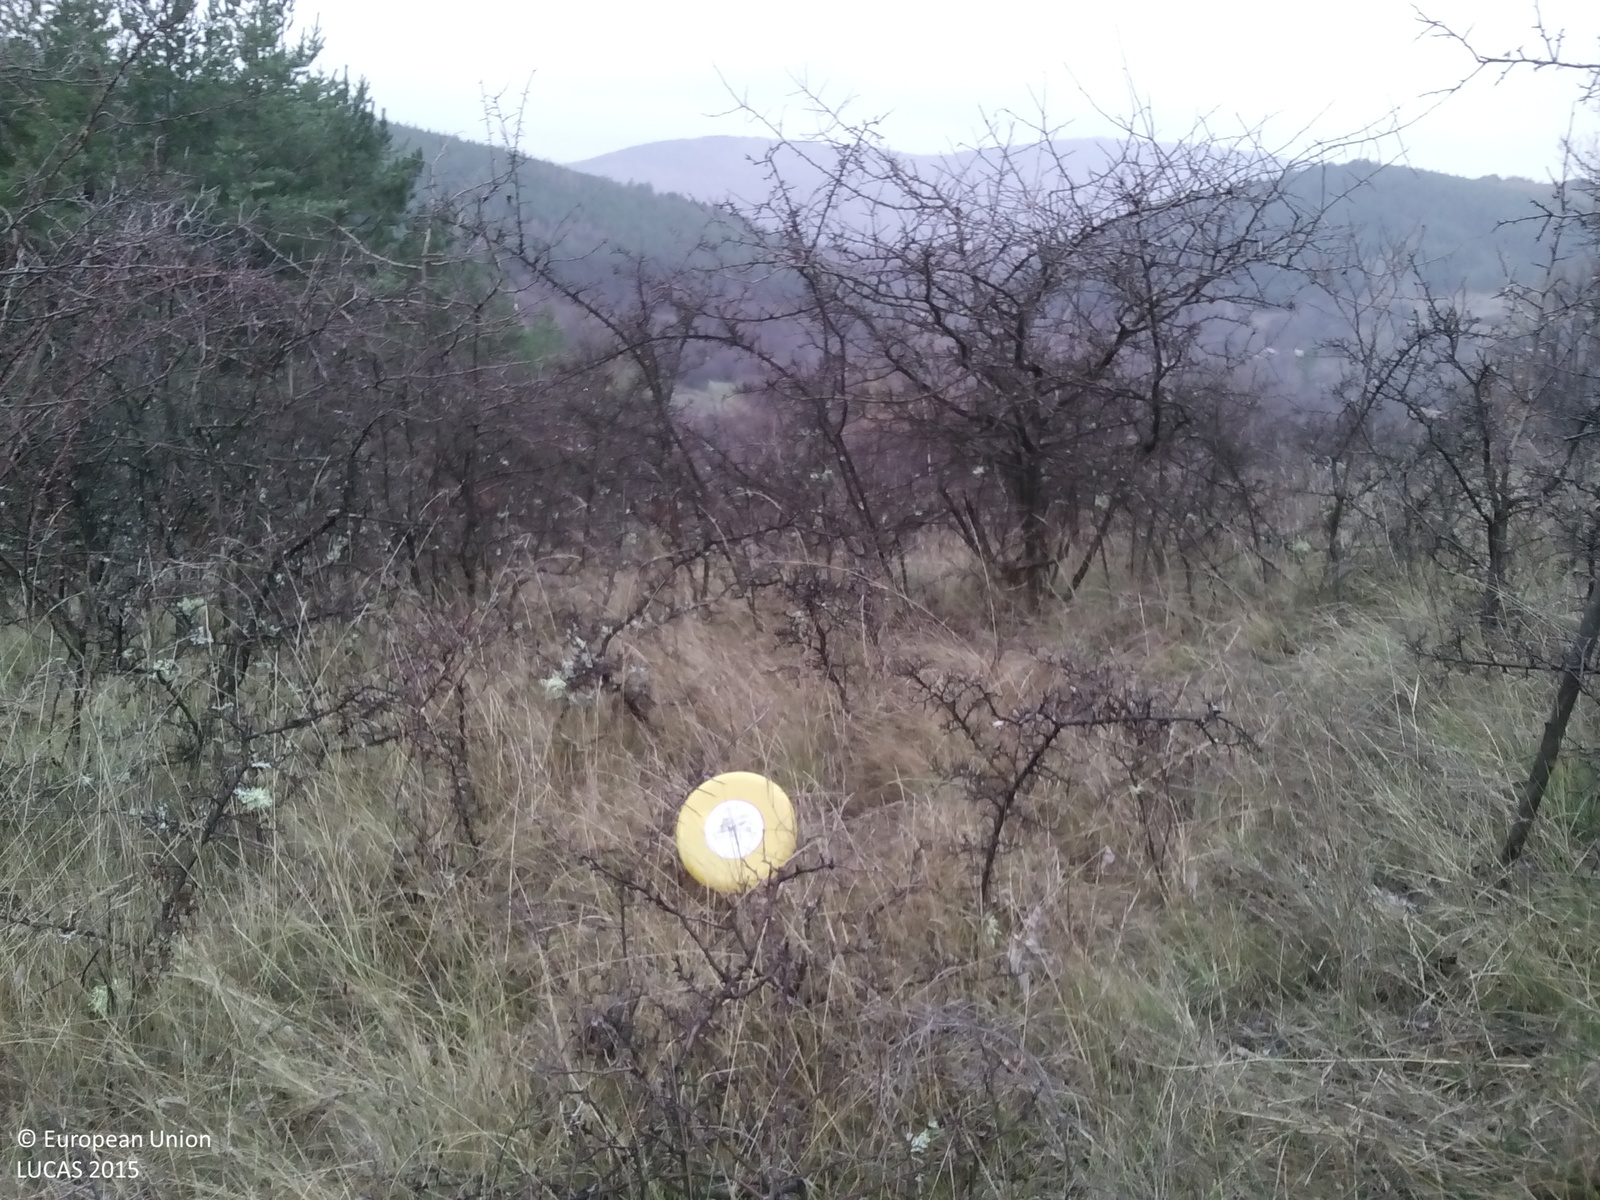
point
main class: Shrubland
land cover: Shrubland with sparse tree cover
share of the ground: 25 - 50 %
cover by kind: herbaceous plants 55 %, shrubs 40 %, coniferous forest trees 5 %
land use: Semi-natural and natural areas not in use
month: December
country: BG
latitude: 42.7959
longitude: 22.8789
